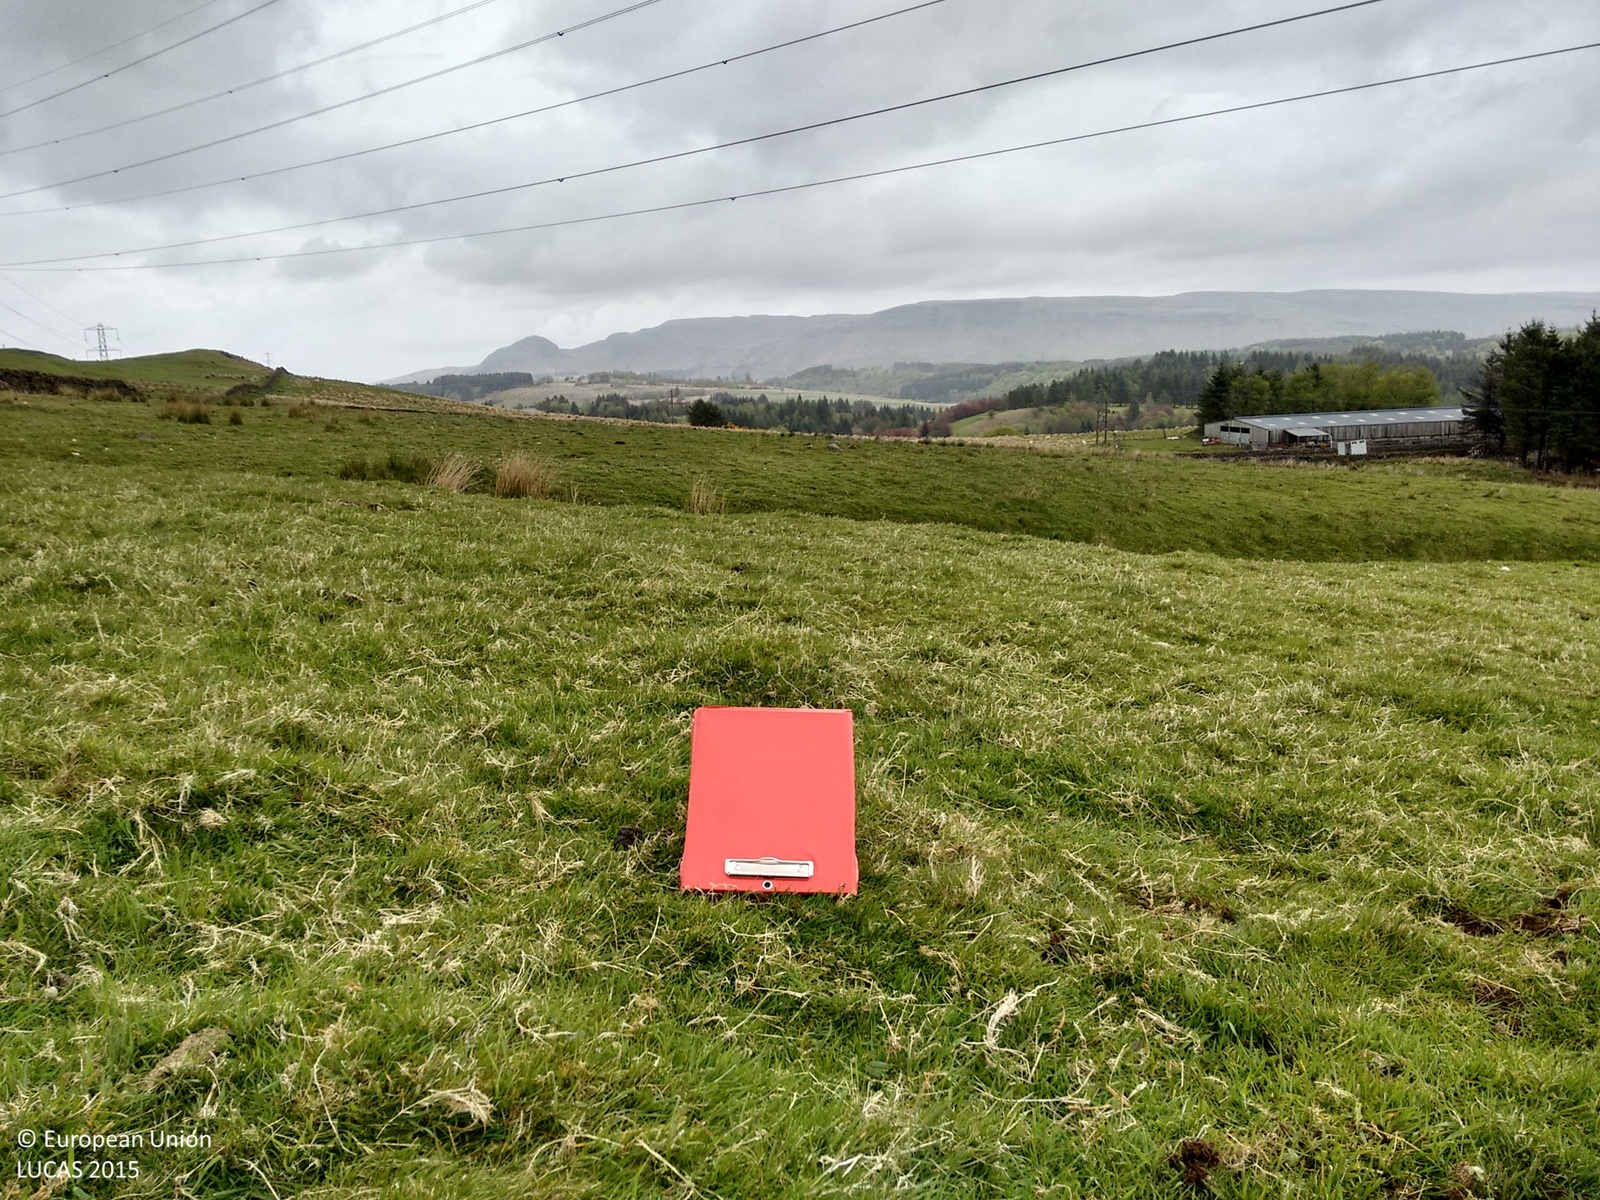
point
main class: Grassland
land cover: Grassland without tree/shrub cover
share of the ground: > 75 %
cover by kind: herbaceous plants 100 %
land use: Agriculture (excluding fallow land and kitchen gardens)
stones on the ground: < 10 %
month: May
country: GB
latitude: 55.9588
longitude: -4.3671
